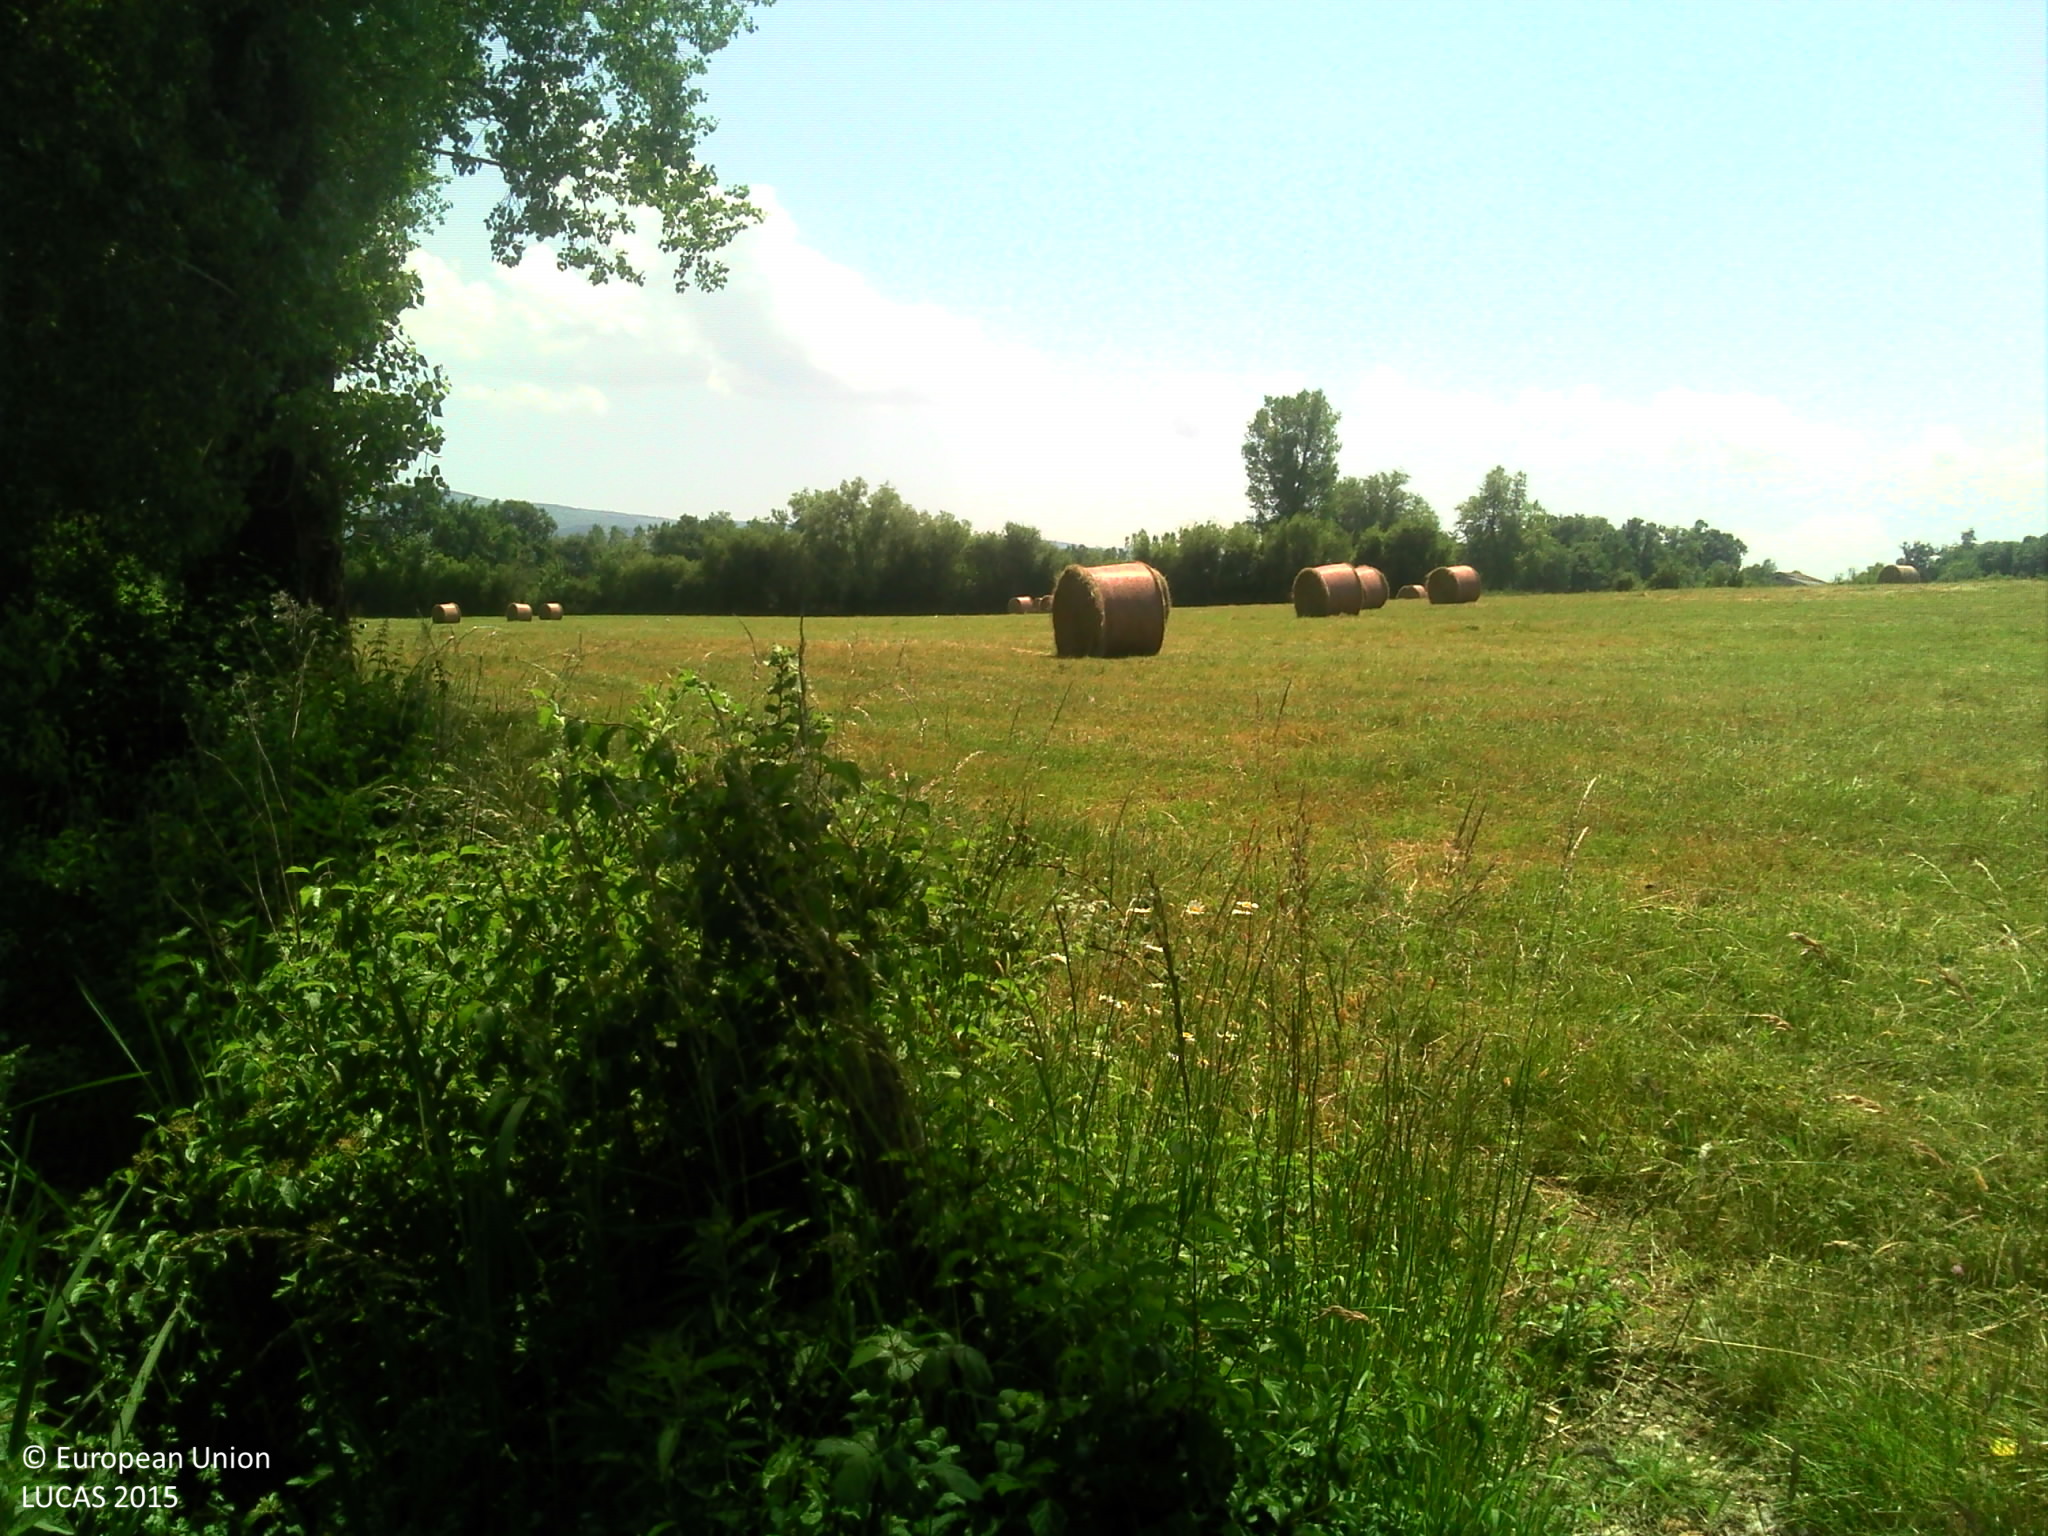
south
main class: Grassland
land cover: Grassland without tree/shrub cover
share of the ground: > 75 %
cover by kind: herbaceous plants 100 %
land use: Agriculture (excluding fallow land and kitchen gardens)
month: June
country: FR
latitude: 43.5274
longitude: 2.1489
